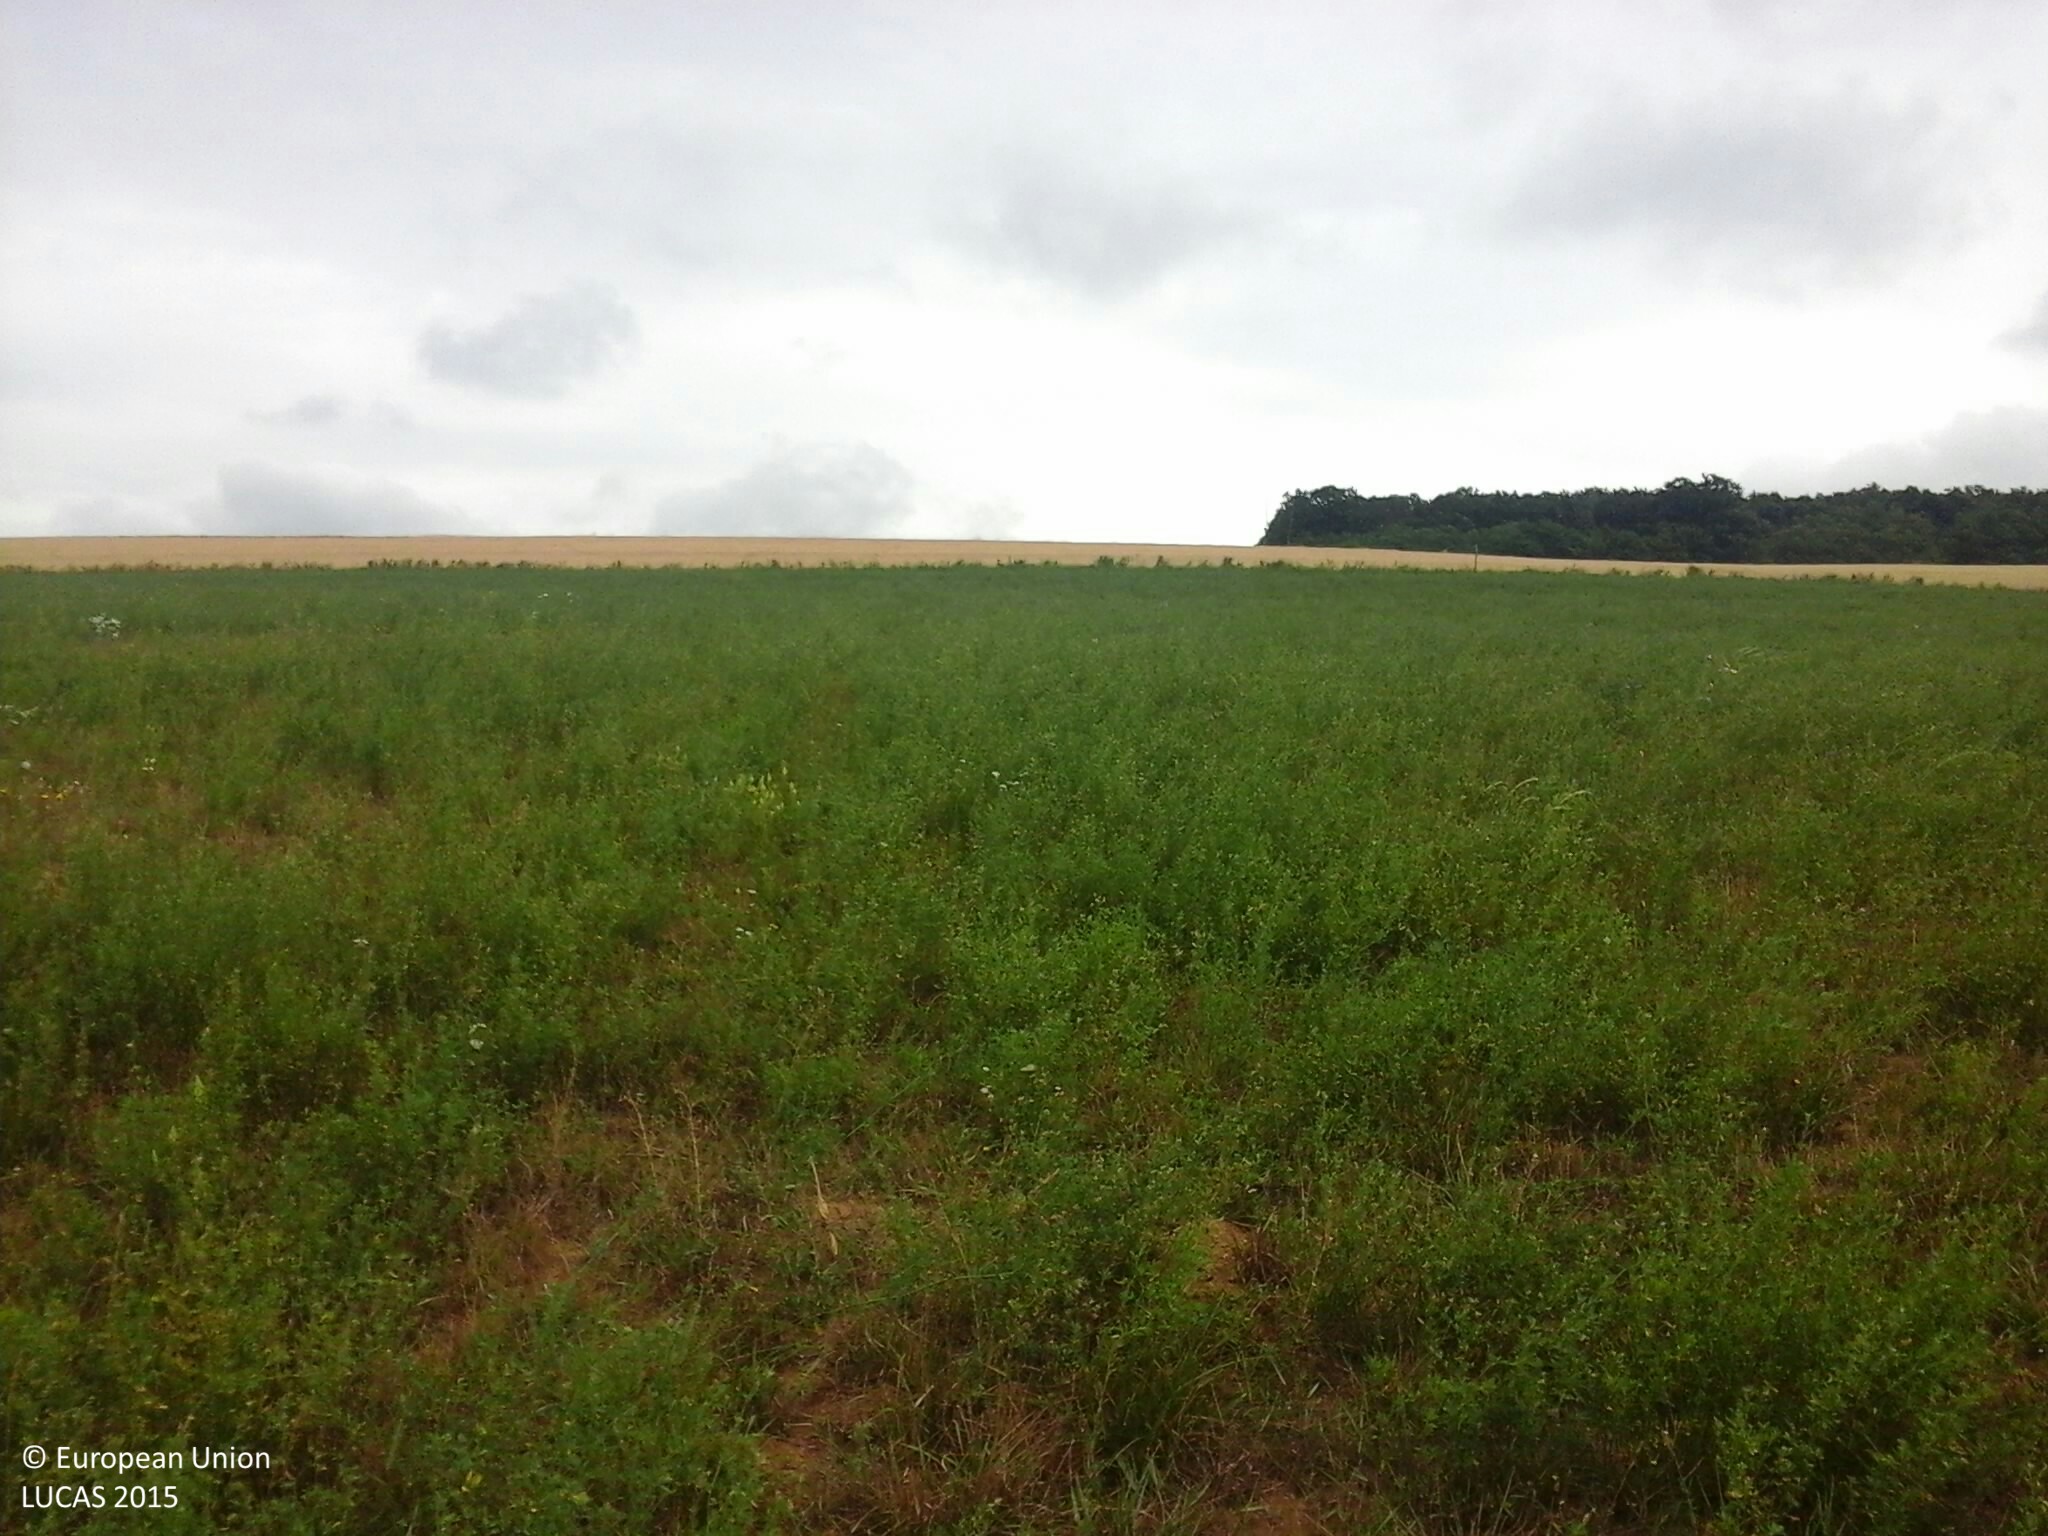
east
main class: Cropland
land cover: Lucerne
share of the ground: > 75 %
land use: Agriculture (excluding fallow land and kitchen gardens)
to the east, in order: Lucerne; Common wheat
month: July
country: HU
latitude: 46.7641
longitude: 17.9033
